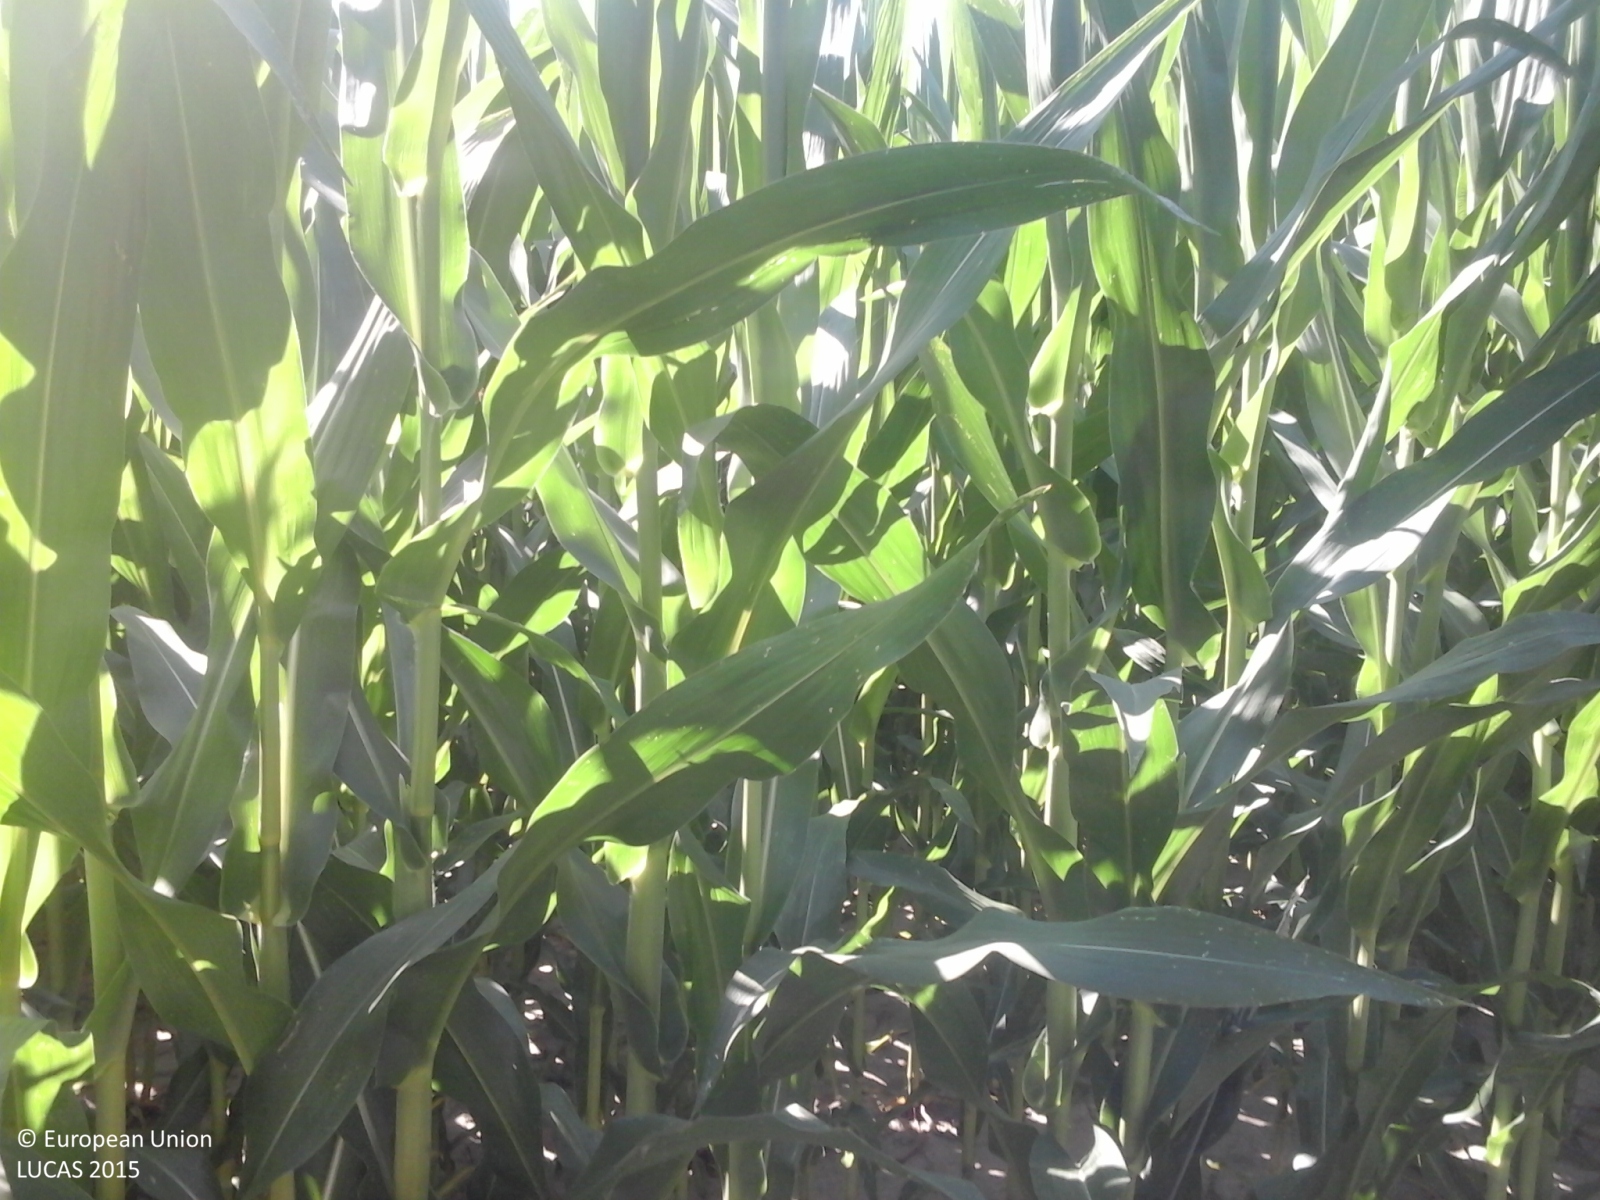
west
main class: Cropland
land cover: Maize
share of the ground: > 75 %
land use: Agriculture (excluding fallow land and kitchen gardens)
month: June
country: IT
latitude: 45.0804
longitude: 8.5925
